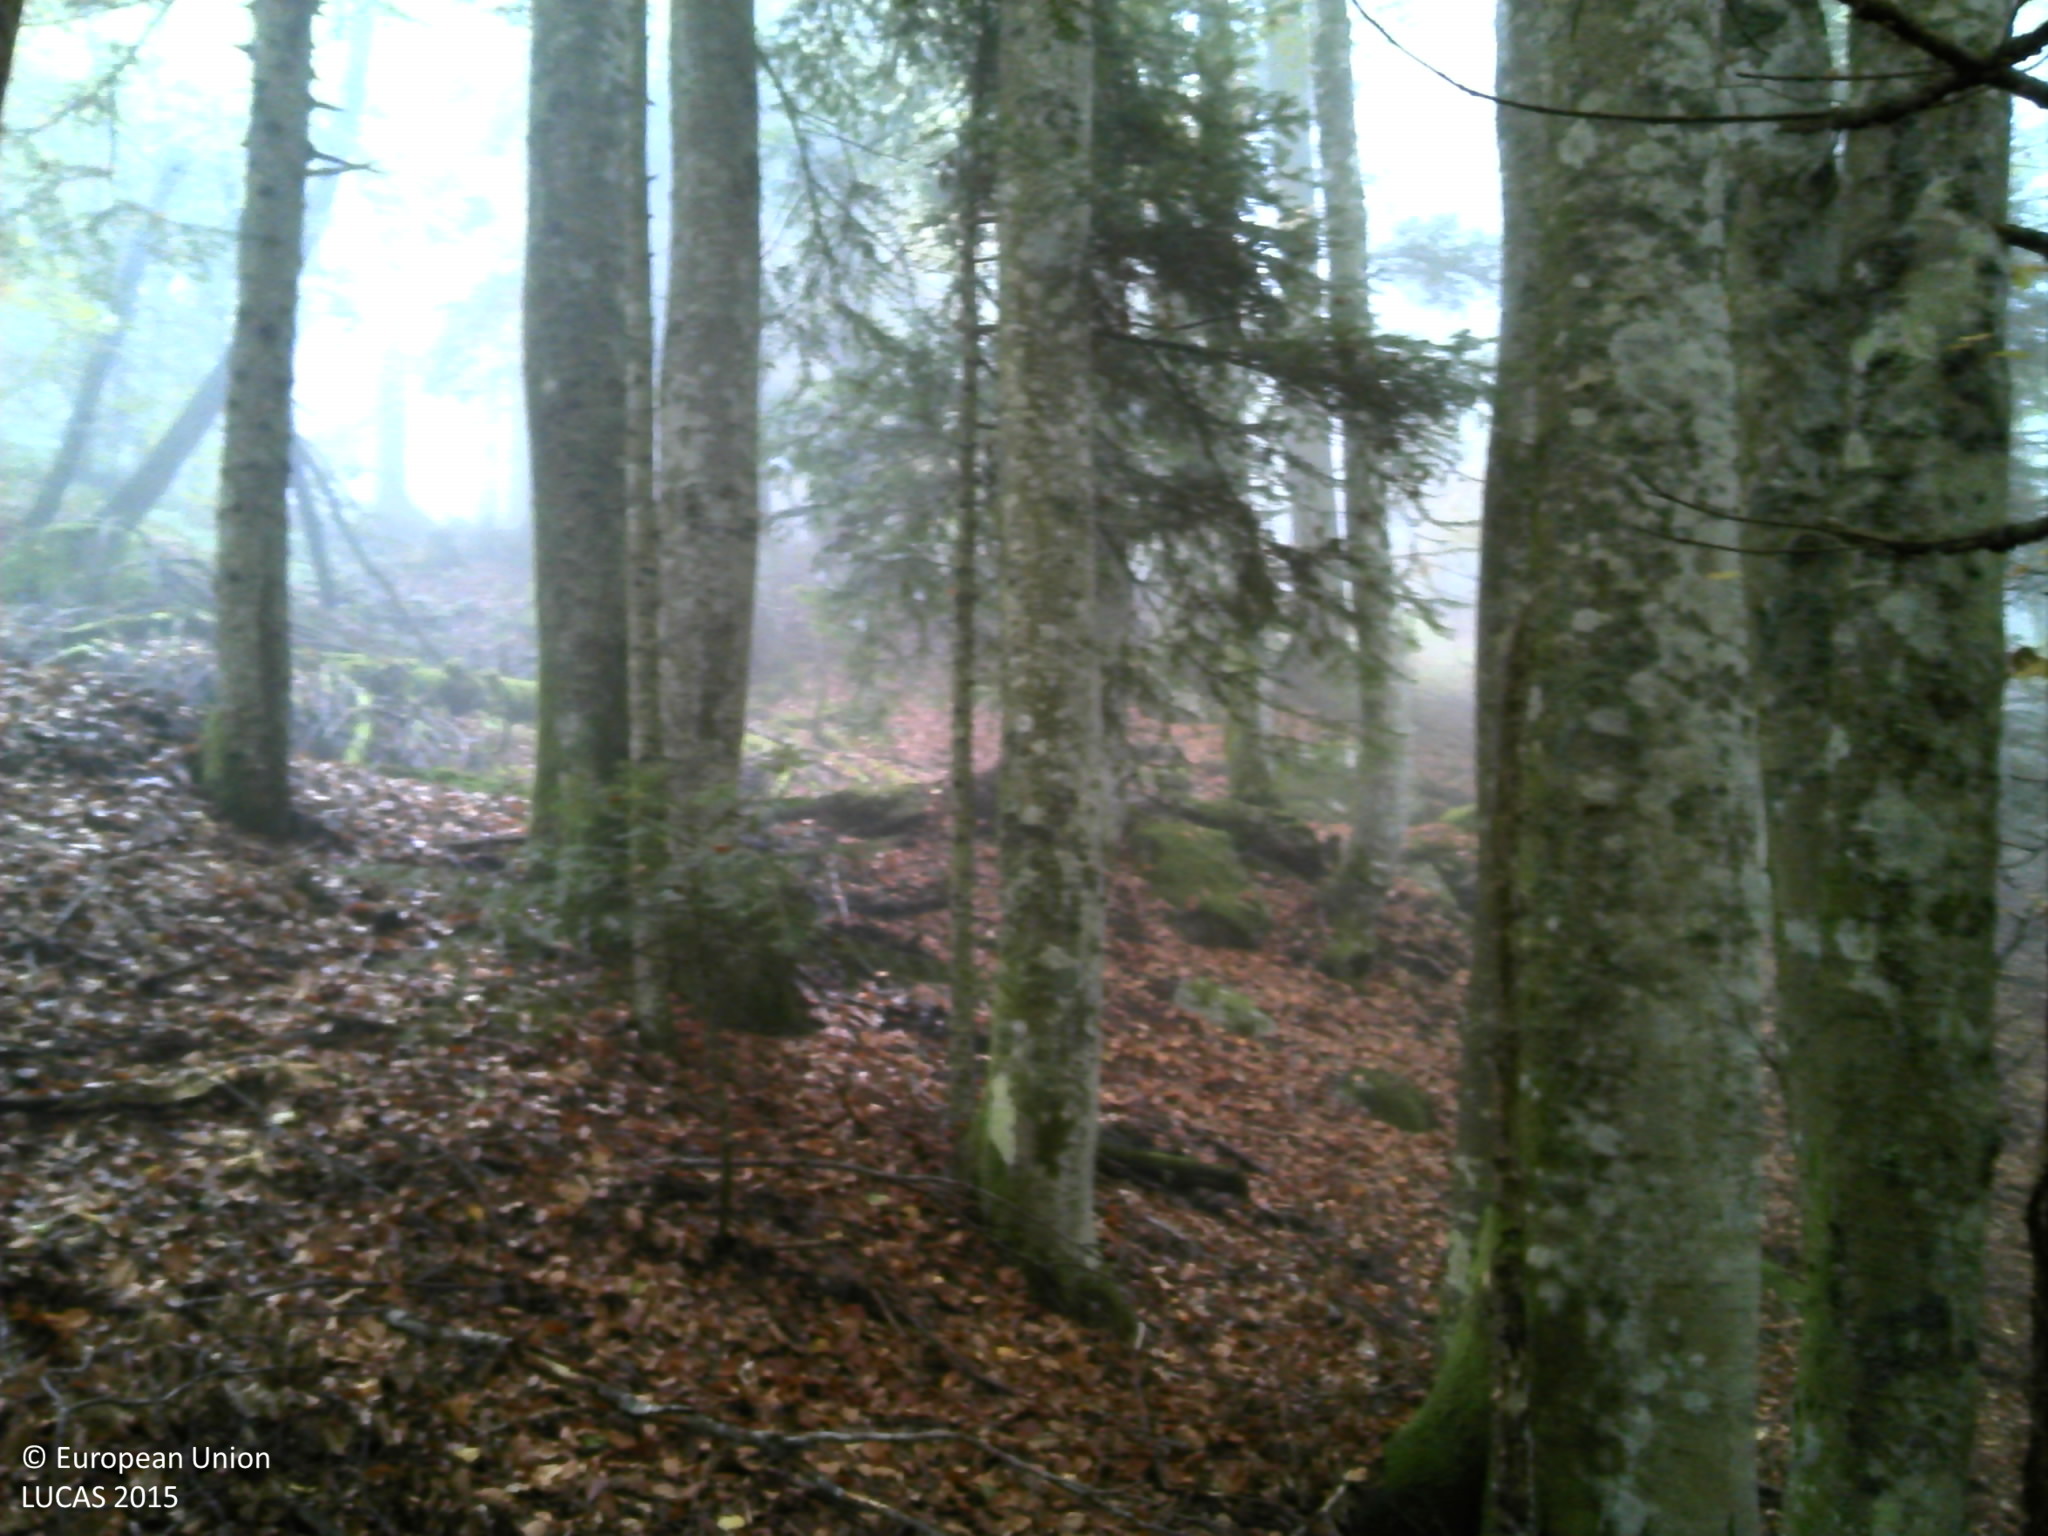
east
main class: Woodland
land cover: Spruce dominated mixed woodland
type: mountainous beech forest
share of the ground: > 75 %
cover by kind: broadleaved forest trees 50 %, coniferous forest trees 40 %, unconsolidated bare surface 10 %
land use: Forestry
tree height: > 5 m
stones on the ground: < 10 %
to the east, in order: Spruce dominated mixed woodland; Tracks; Spruce dominated mixed woodland; Grass margins; Tracks; Grass margins; Ditches and canals; Spruce dominated mixed woodland
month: October
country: FR
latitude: 45.6447
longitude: 3.7535
